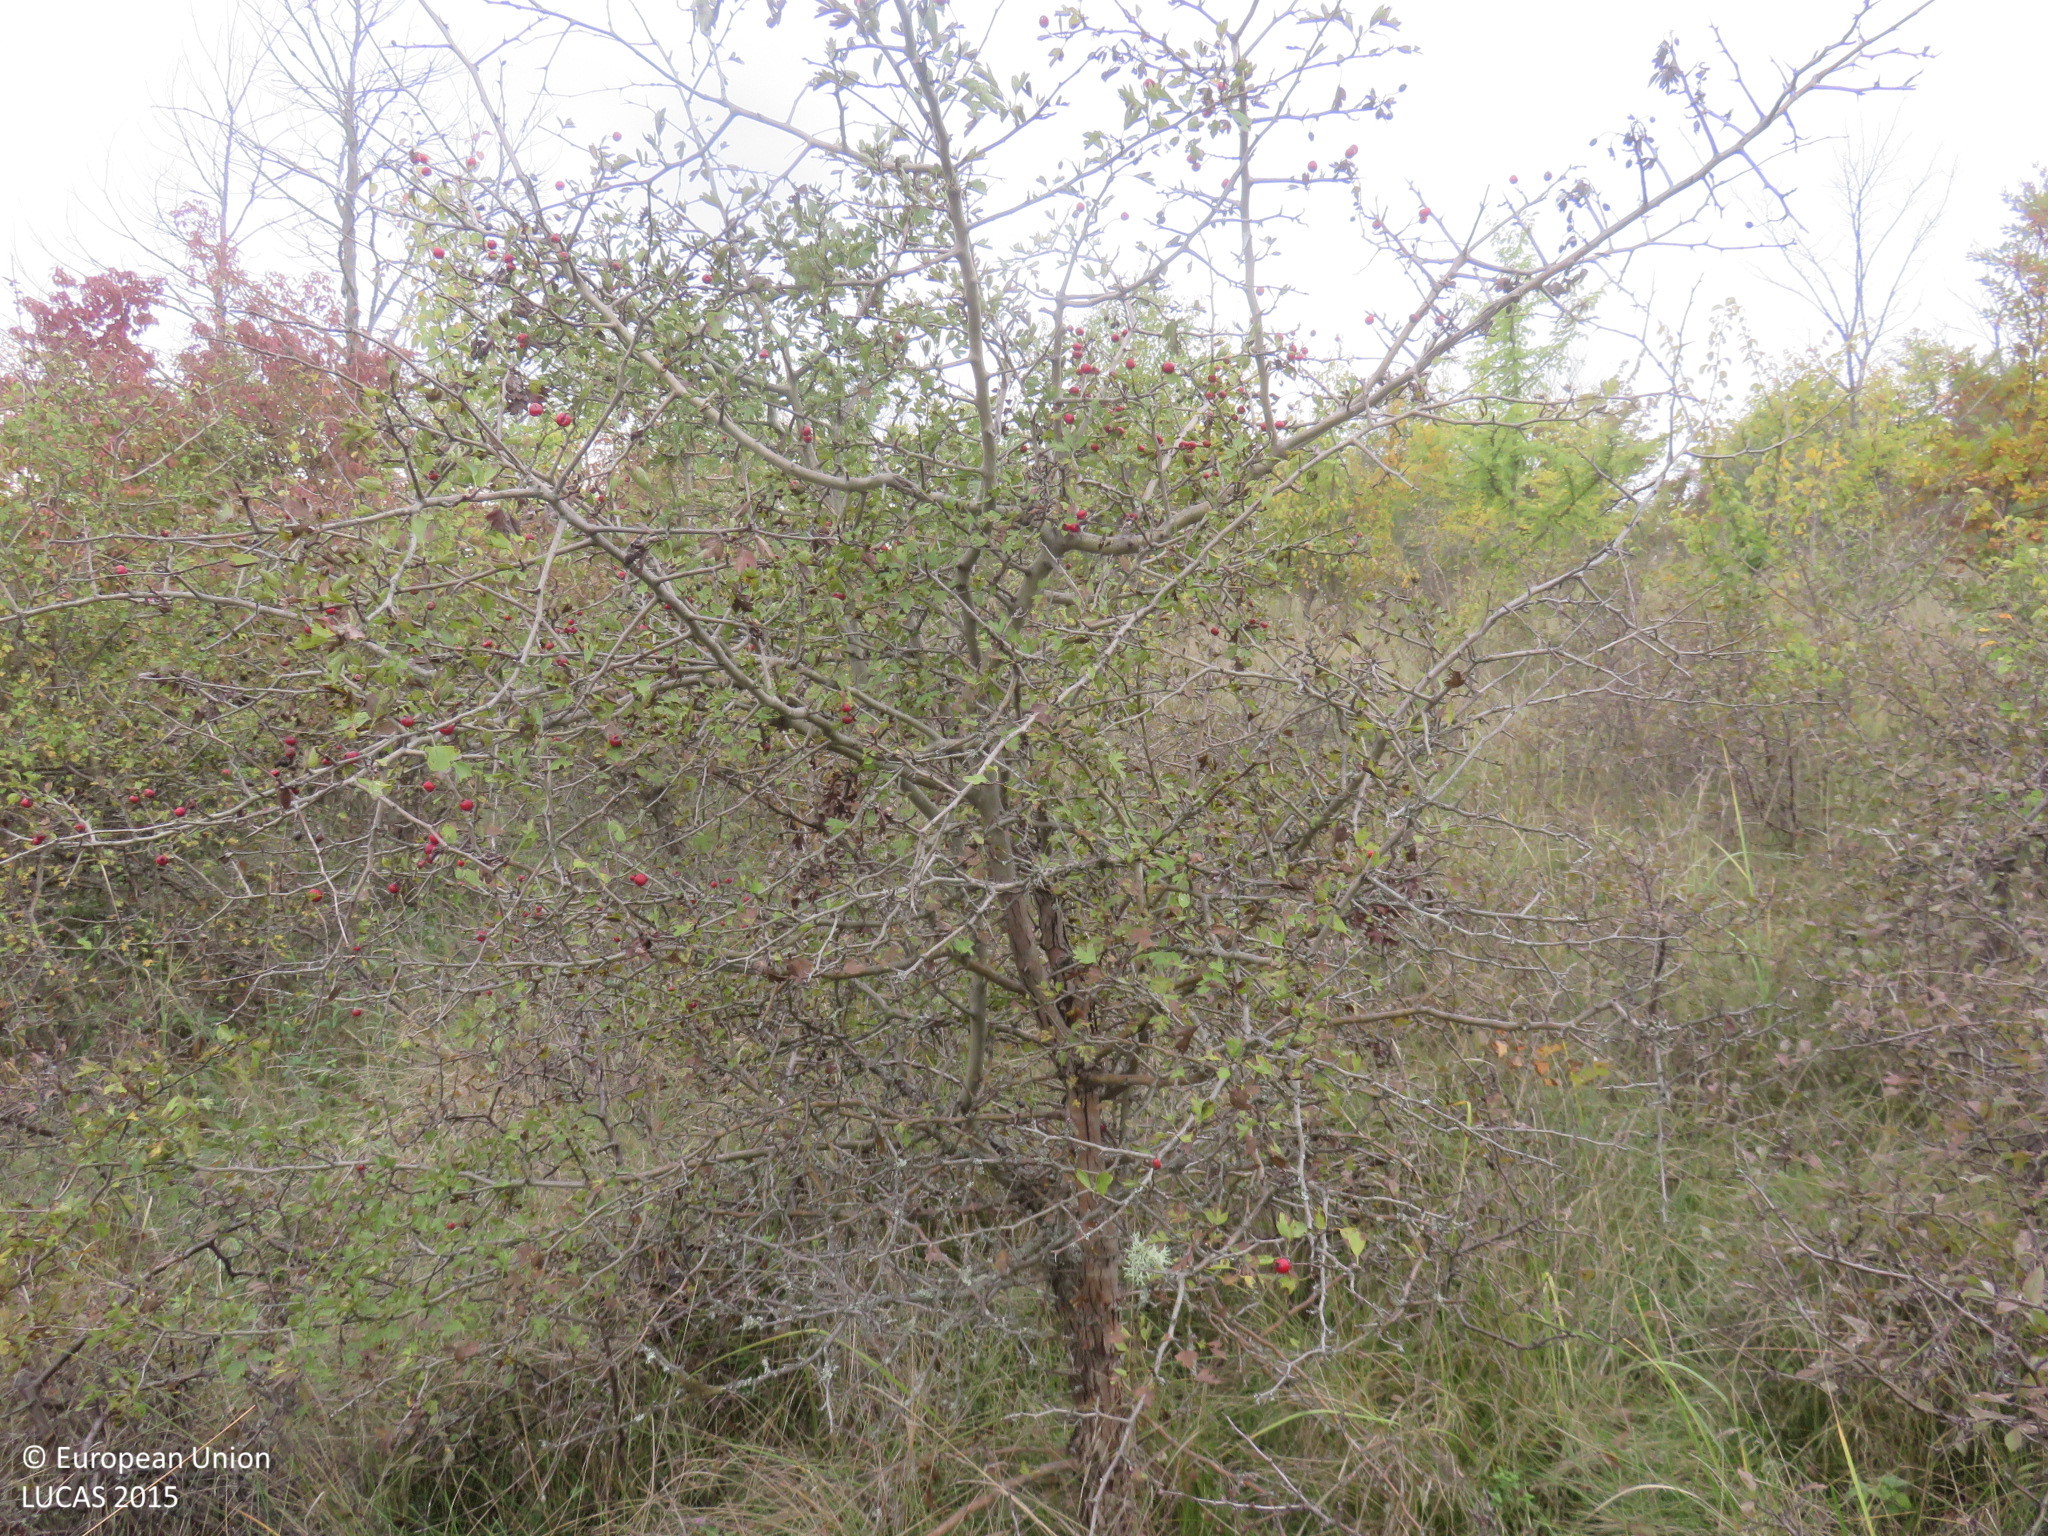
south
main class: Woodland
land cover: Broadleaved woodland
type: mesophytic deciduous forest
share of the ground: 10 - 25 %
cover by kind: shrubs 40 %, herbaceous plants 40 %, broadleaved forest trees 15 %, coniferous forest trees 5 %
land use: Semi-natural and natural areas not in use
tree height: < 5 m
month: October
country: BG
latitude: 42.9933
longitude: 25.1428
